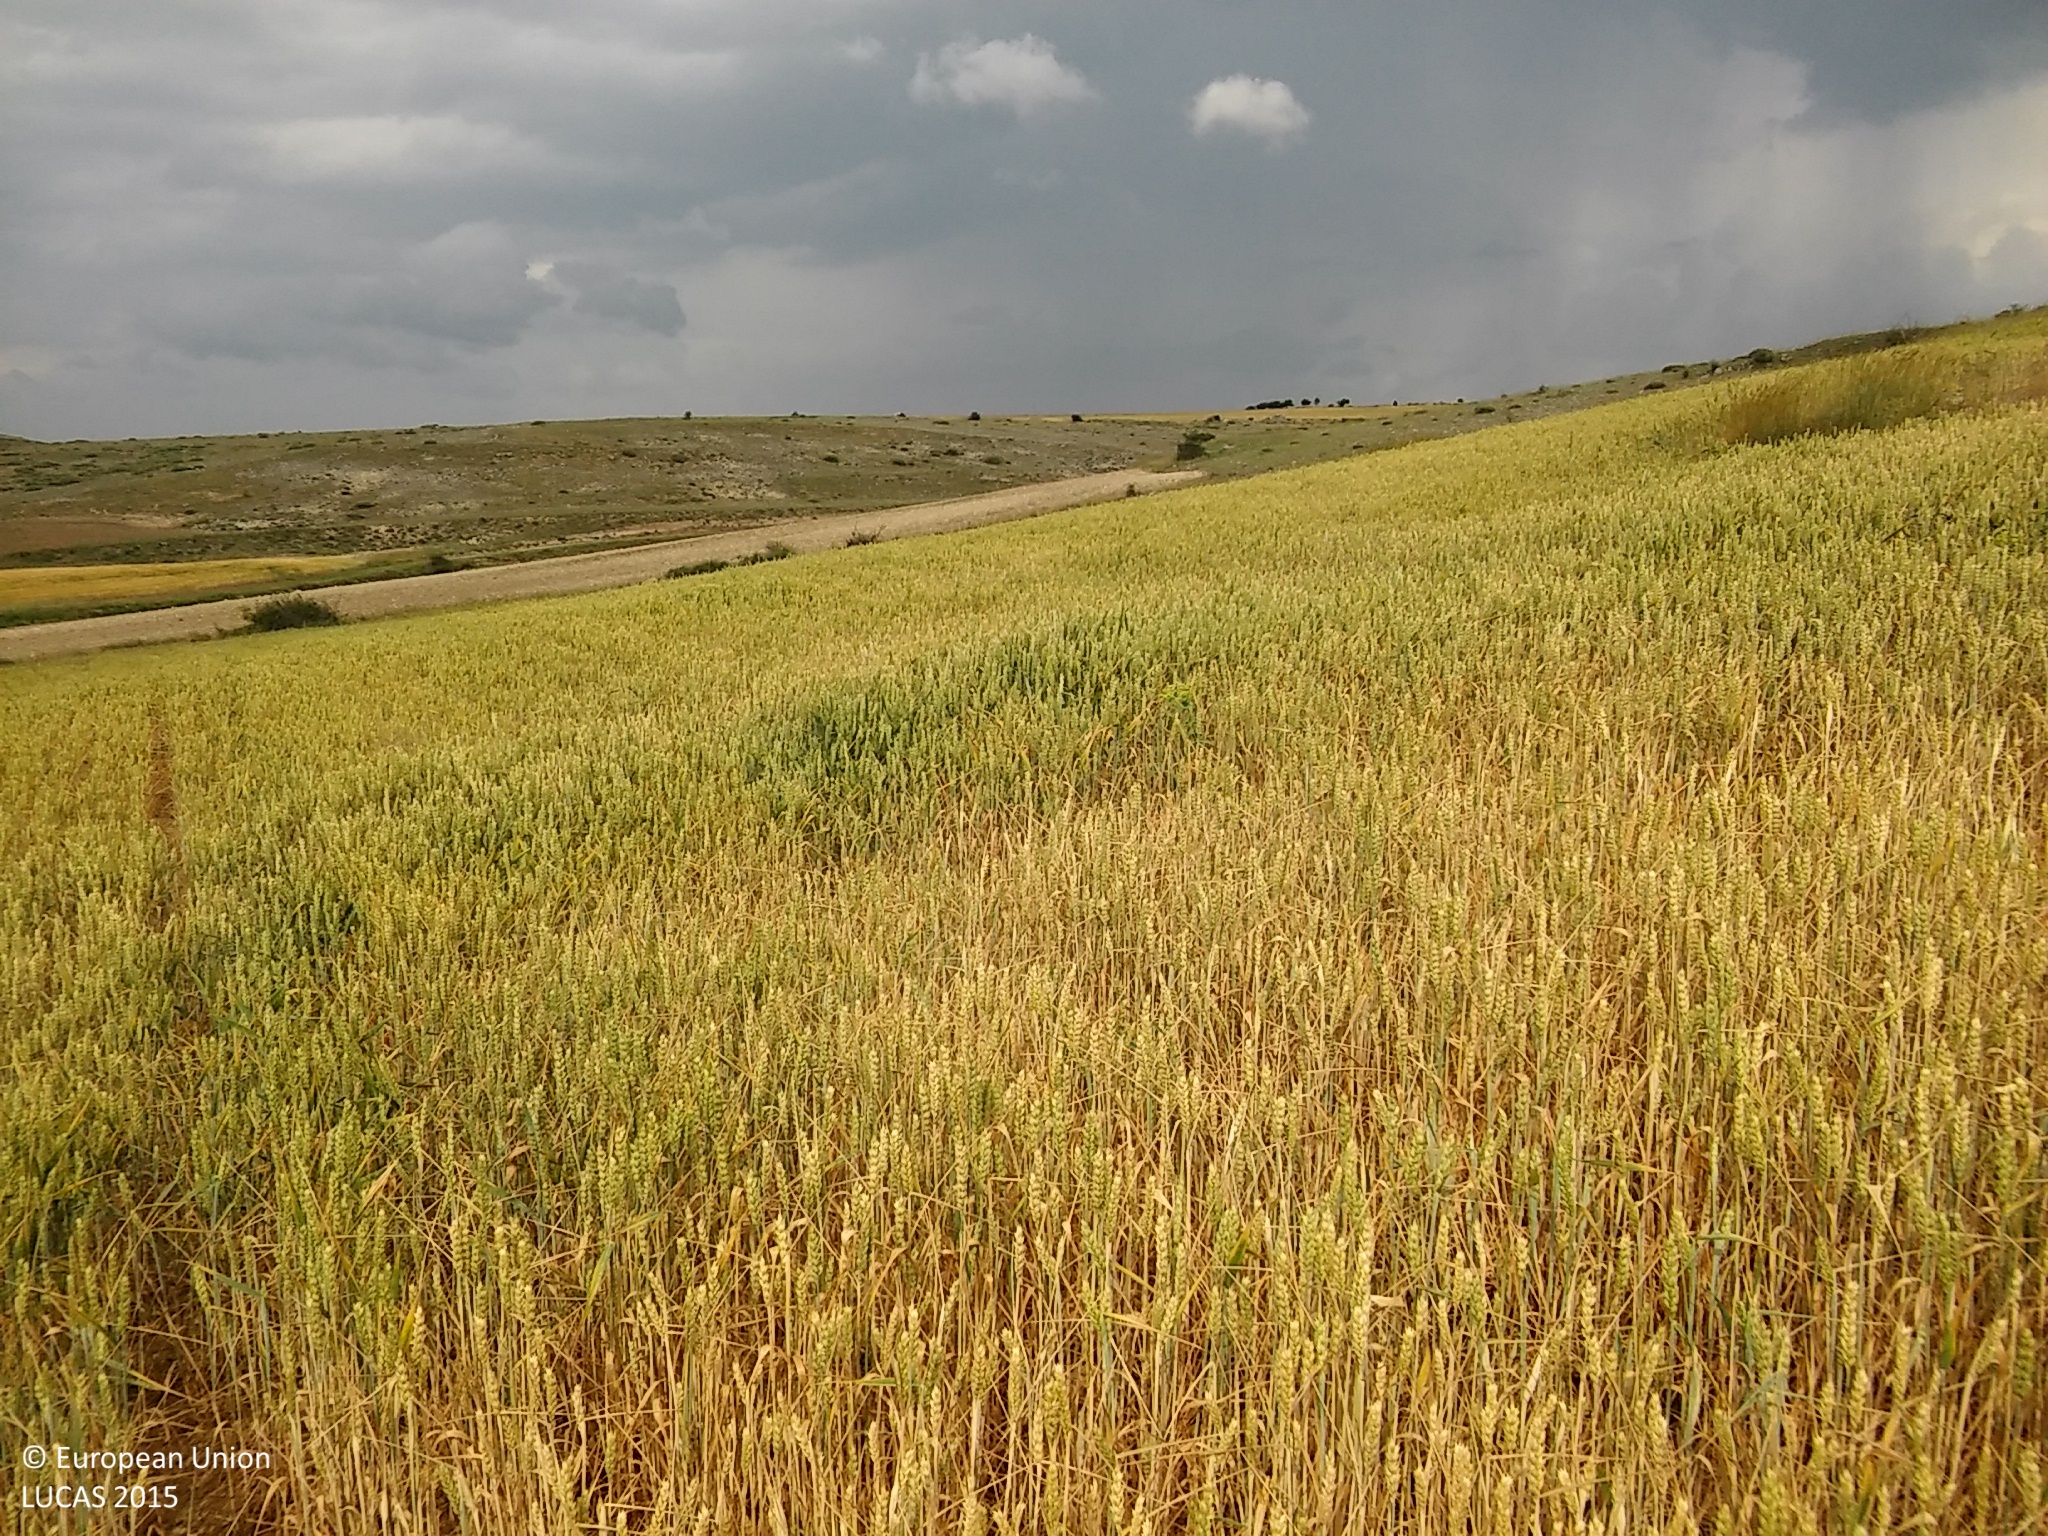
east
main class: Cropland
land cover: Common wheat
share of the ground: > 75 %
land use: Agriculture (excluding fallow land and kitchen gardens)
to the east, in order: Common wheat; Grass margins; Dry stone walls; Ditches and canals; Grassland without tree/shrub cover; Shrubland without tree cover; Other bare soil; Shrubland without tree cover
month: June
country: ES
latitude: 41.2023
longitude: -3.7257
